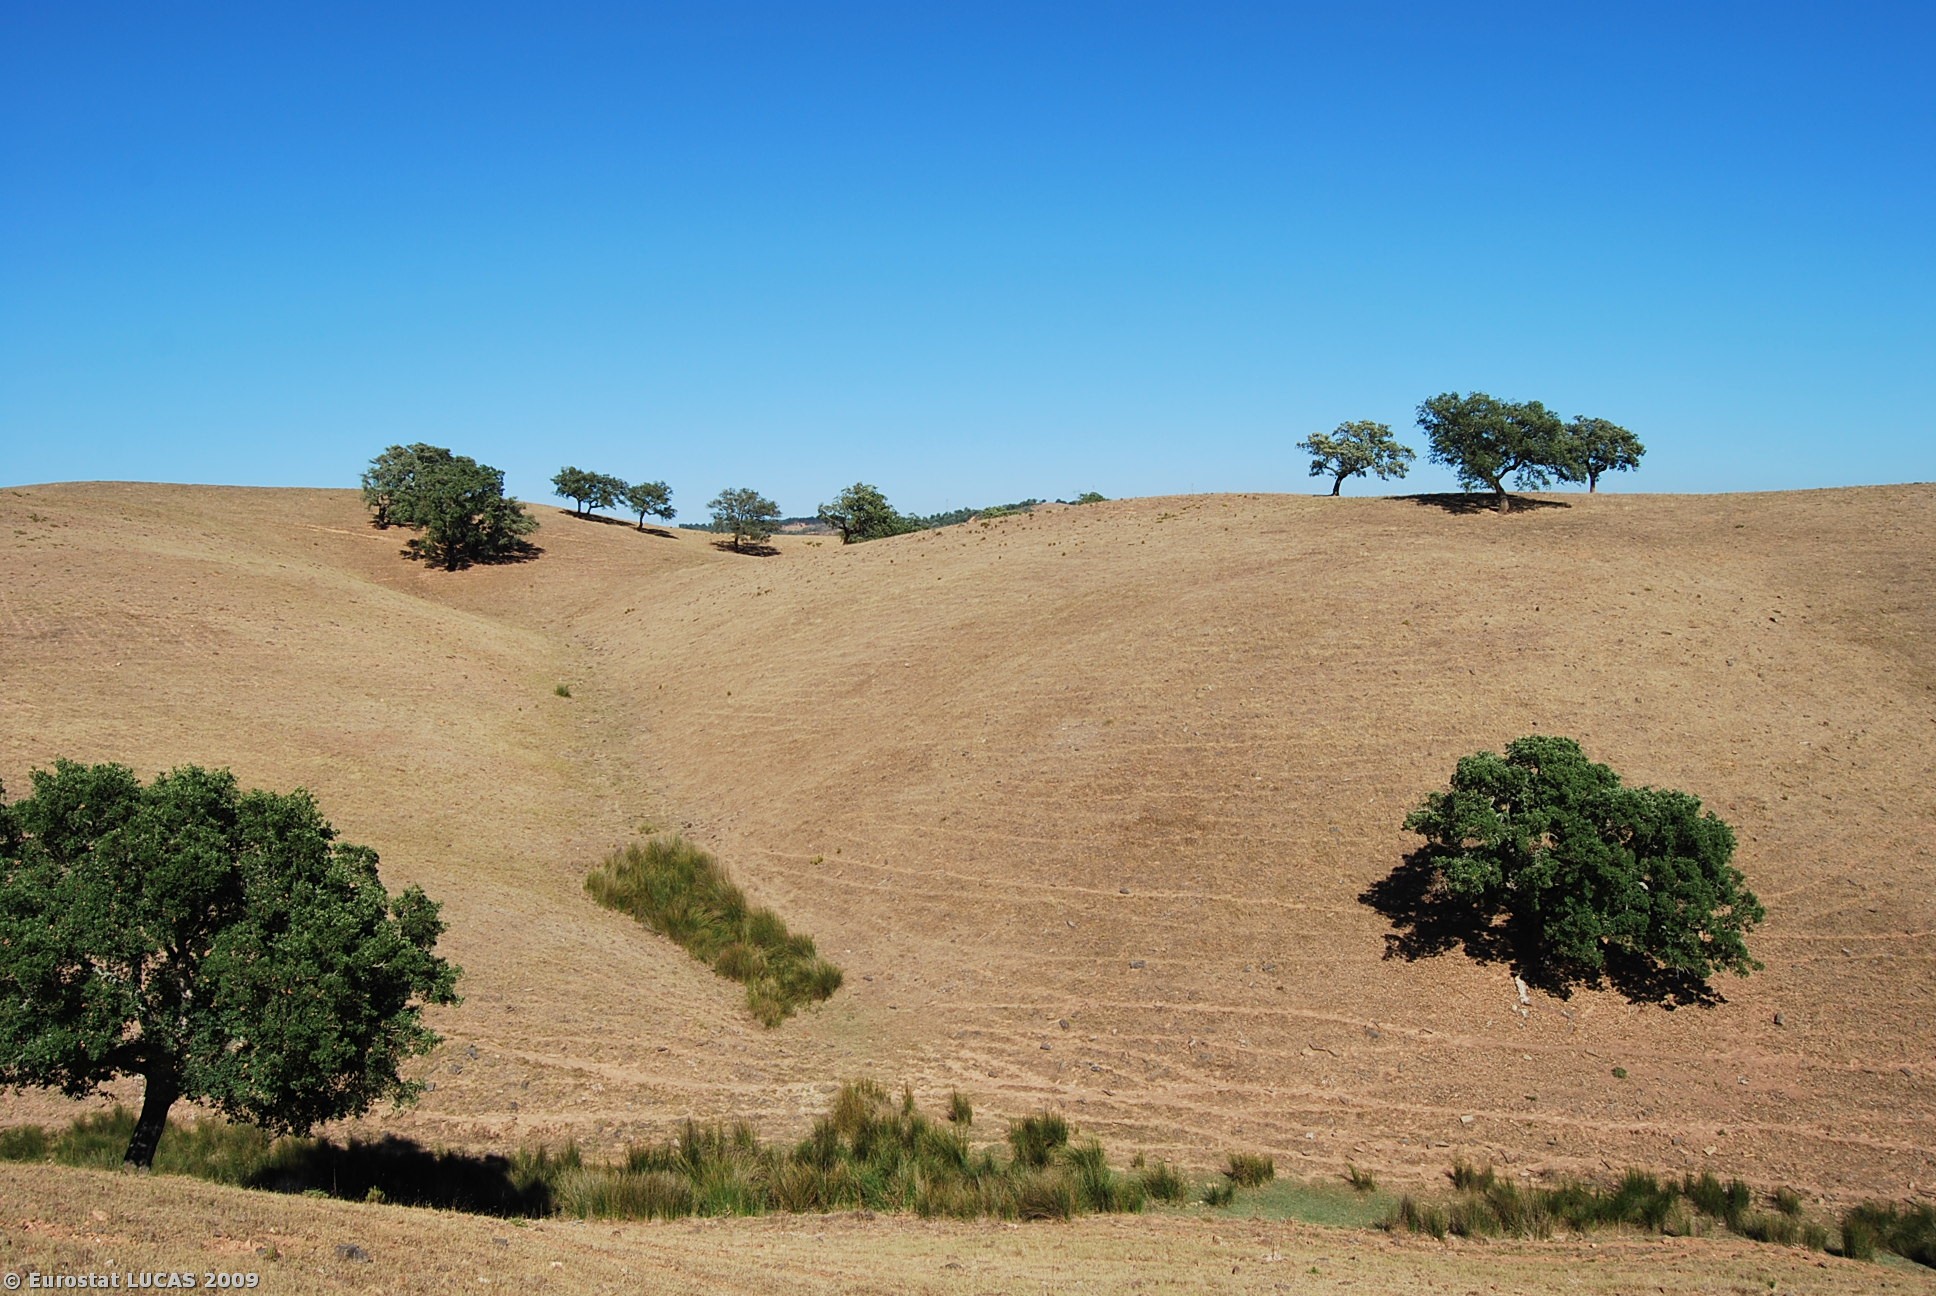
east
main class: Grassland
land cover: Grassland without tree/shrub cover
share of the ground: > 75 %
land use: Agriculture (excluding fallow land and kitchen gardens)
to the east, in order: Grassland without tree/shrub cover; Rivers and streams; Spontaneously vegetated surfaces; Grassland without tree/shrub cover; Broadleaved woodland; Tracks
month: July
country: PT
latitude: 37.5826
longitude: -8.5967
